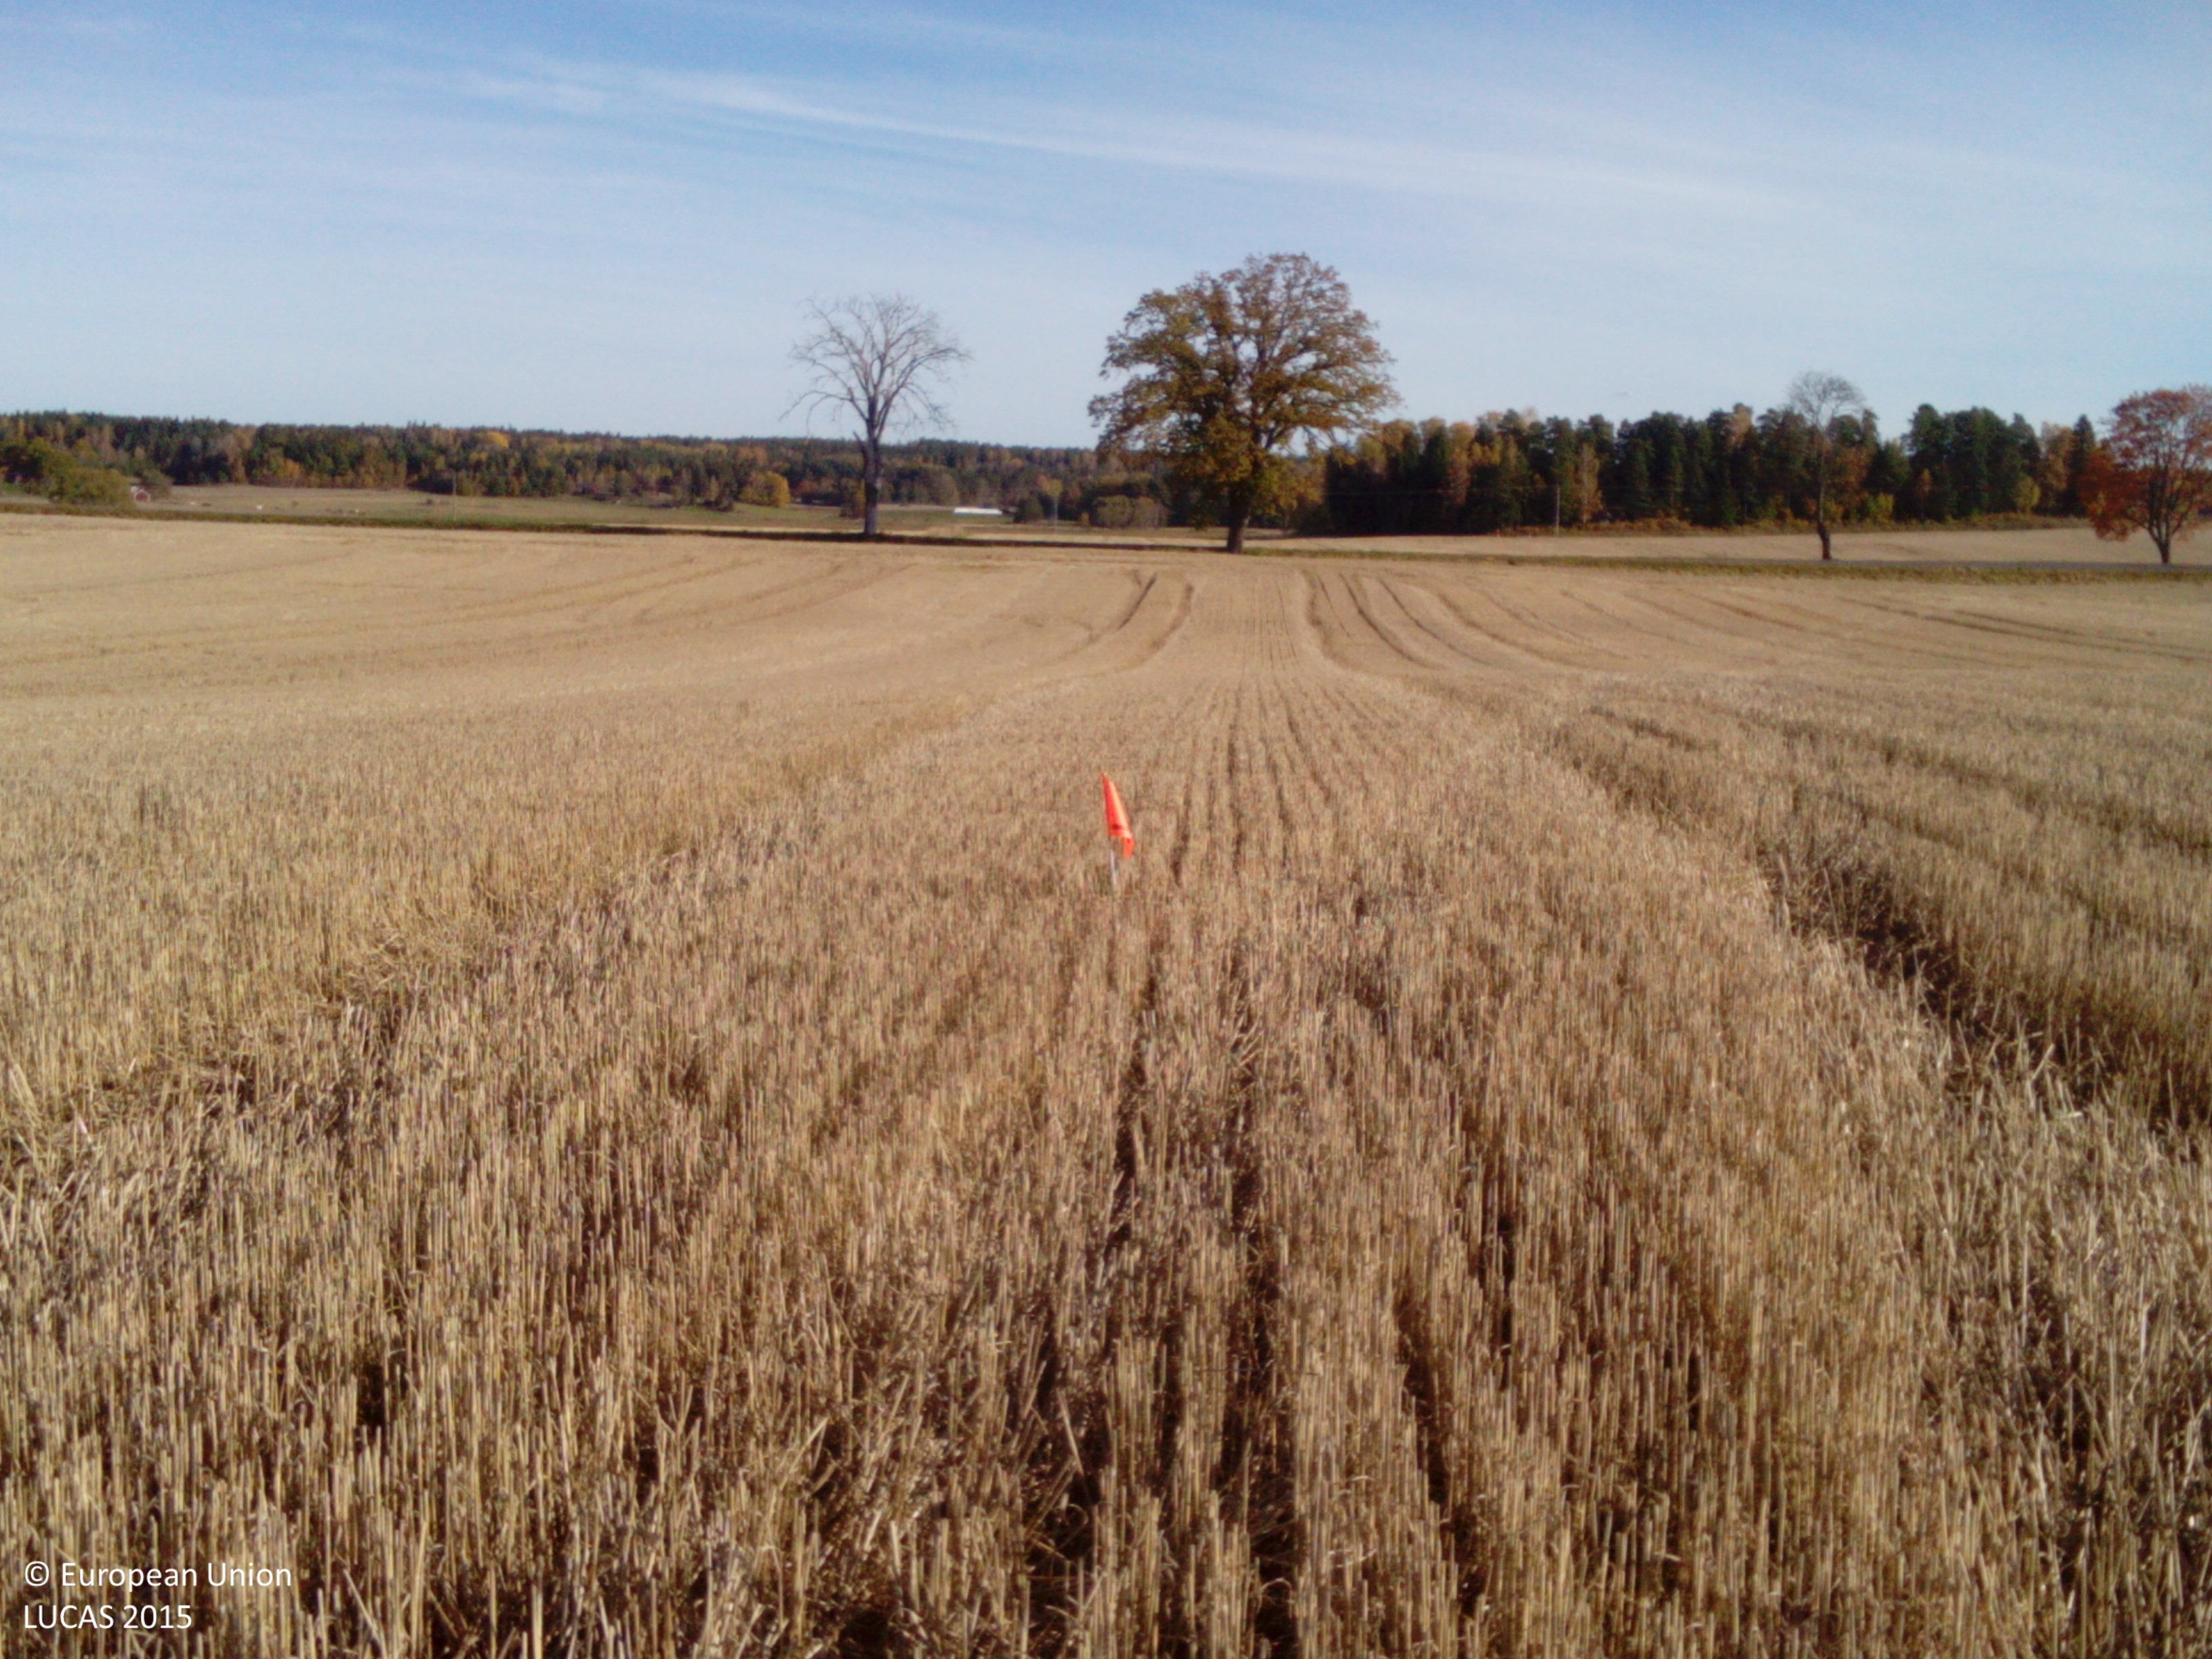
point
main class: Cropland
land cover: Common wheat
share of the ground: > 75 %
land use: Agriculture (excluding fallow land and kitchen gardens)
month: October
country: SE
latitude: 59.0408
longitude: 16.4250
